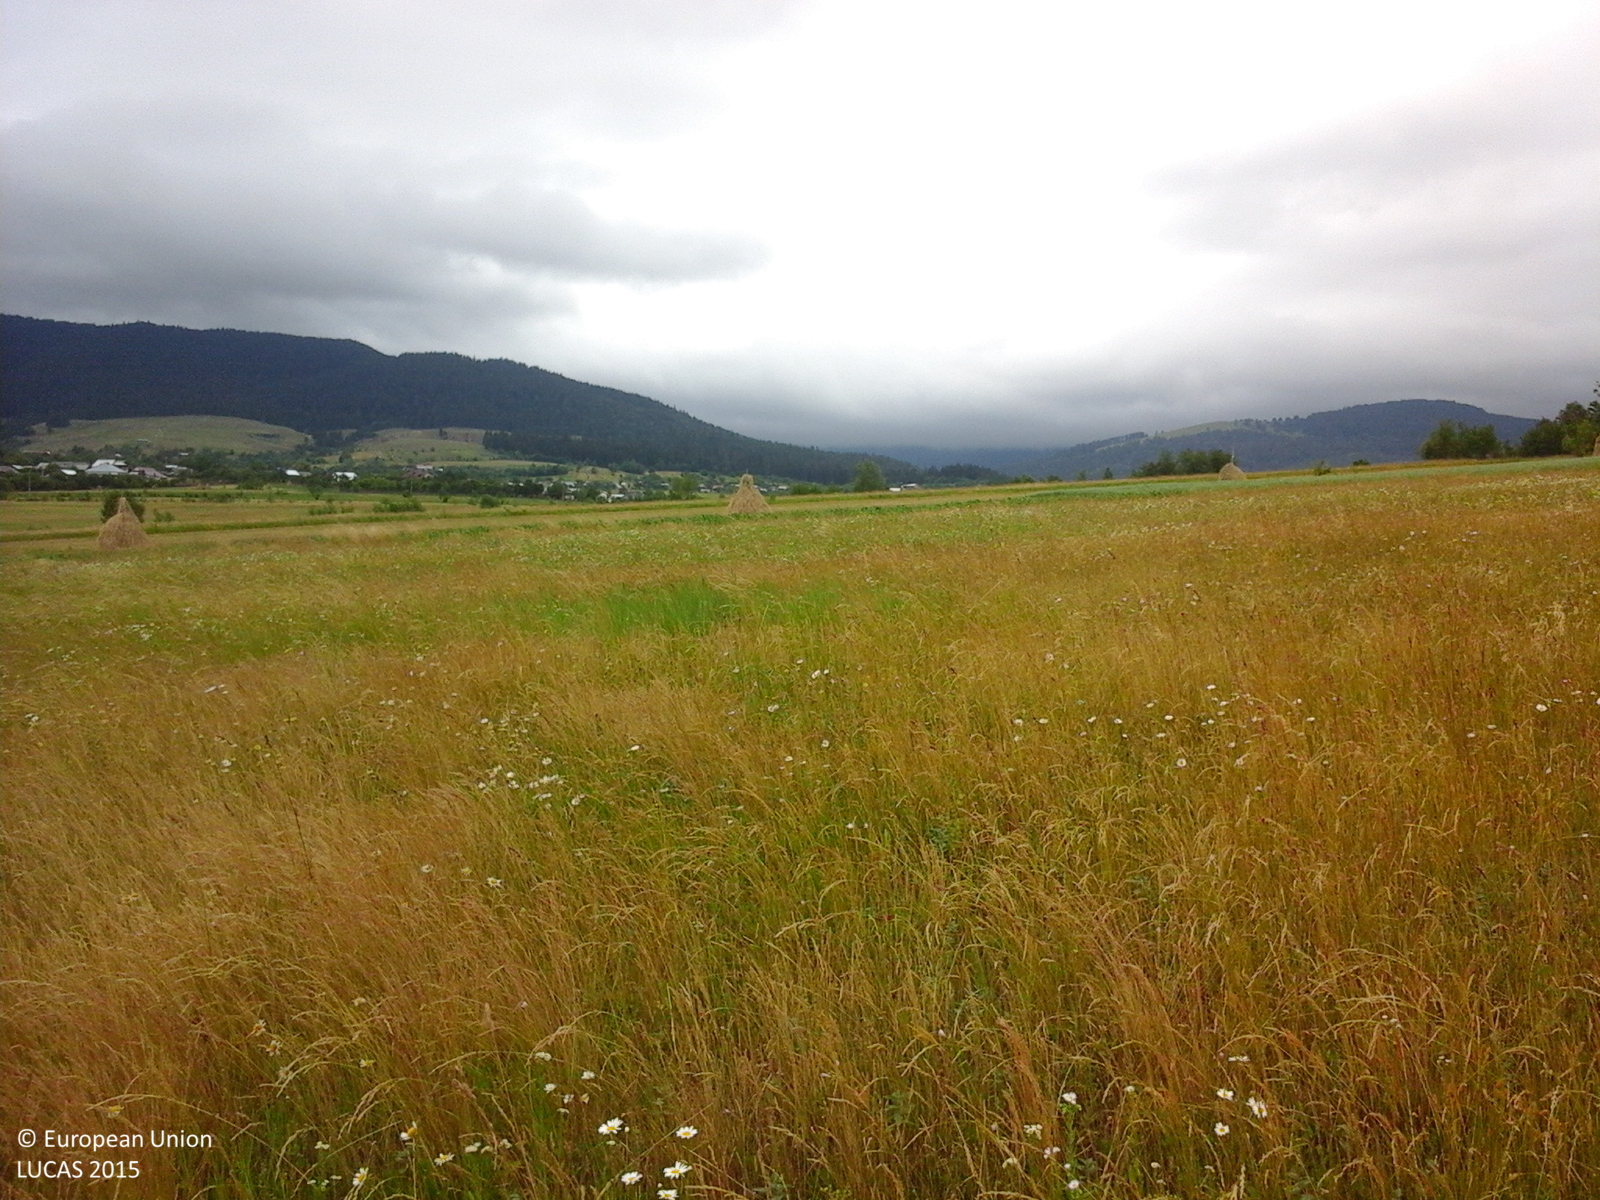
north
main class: Grassland
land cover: Grassland without tree/shrub cover
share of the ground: > 75 %
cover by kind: herbaceous plants 100 %
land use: Agriculture (excluding fallow land and kitchen gardens)
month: June
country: RO
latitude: 47.1656
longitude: 26.2939
